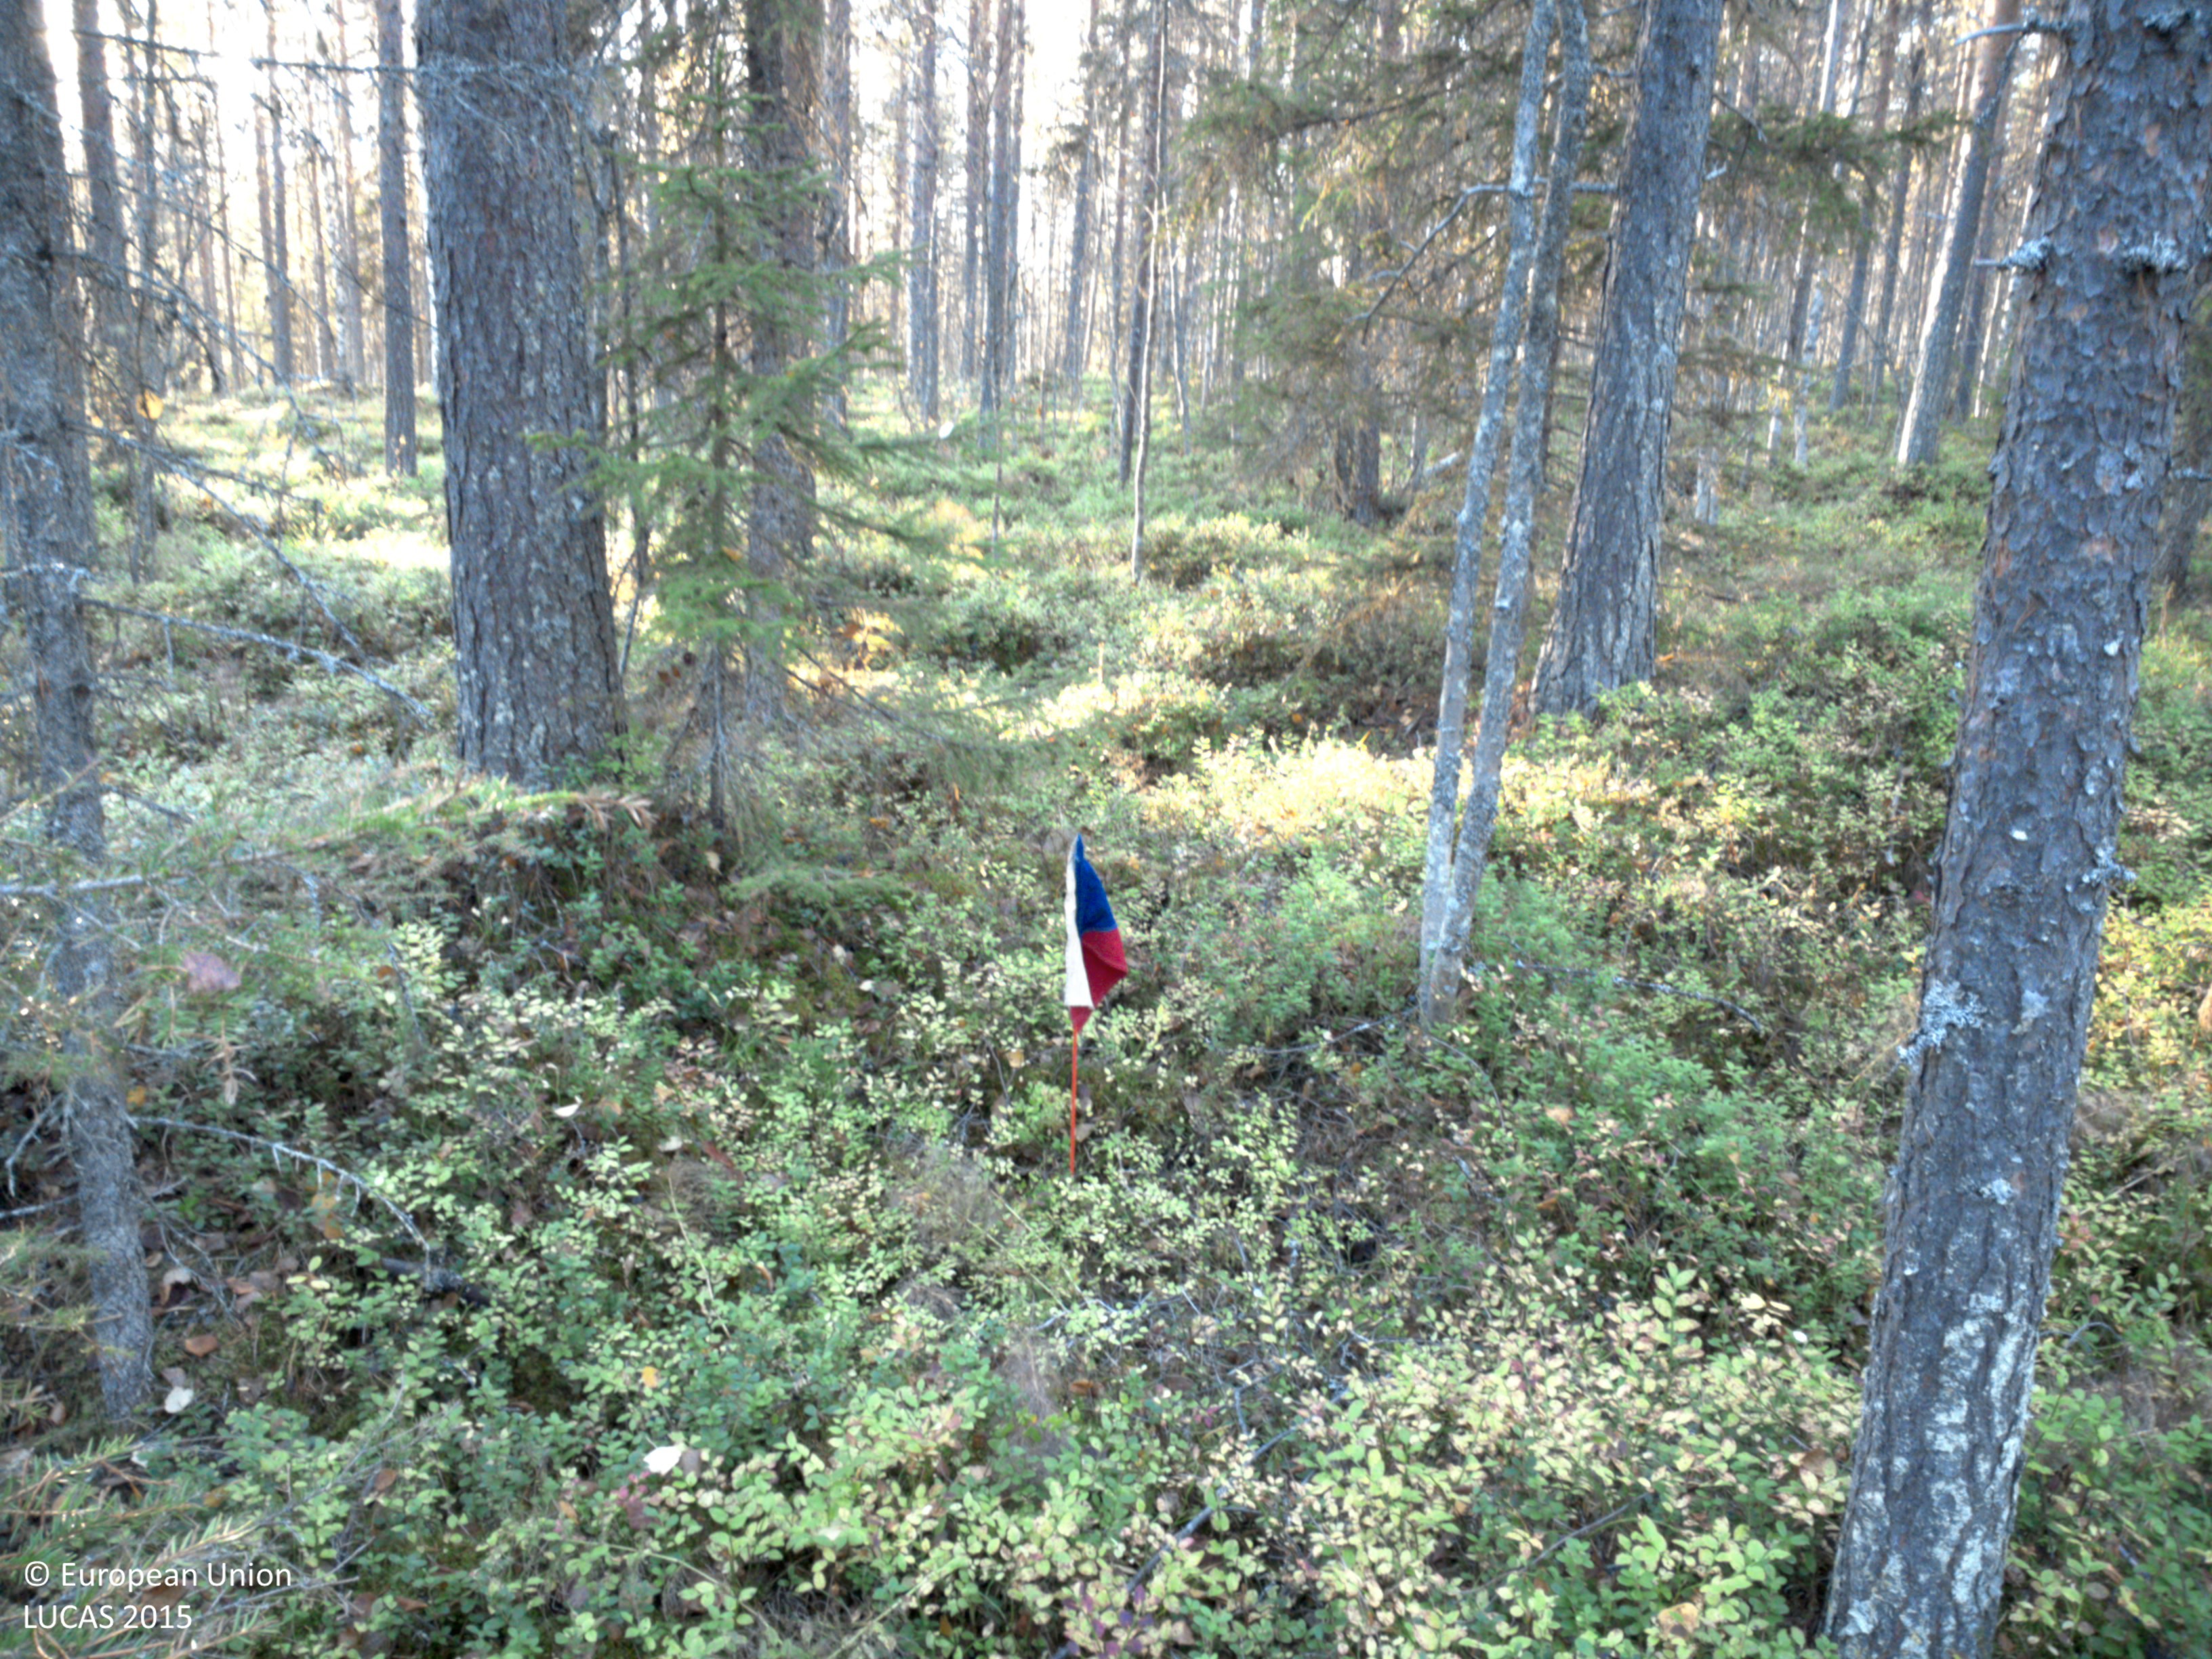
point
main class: Woodland
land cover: Pine dominated mixed woodland
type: boreal forest
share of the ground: 50 - 75 %
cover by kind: coniferous forest trees 45 %, shrubs 40 %, broadleaved forest trees 15 %
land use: Forestry
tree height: > 5 m
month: September
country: SE
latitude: 64.9430
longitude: 18.3233
